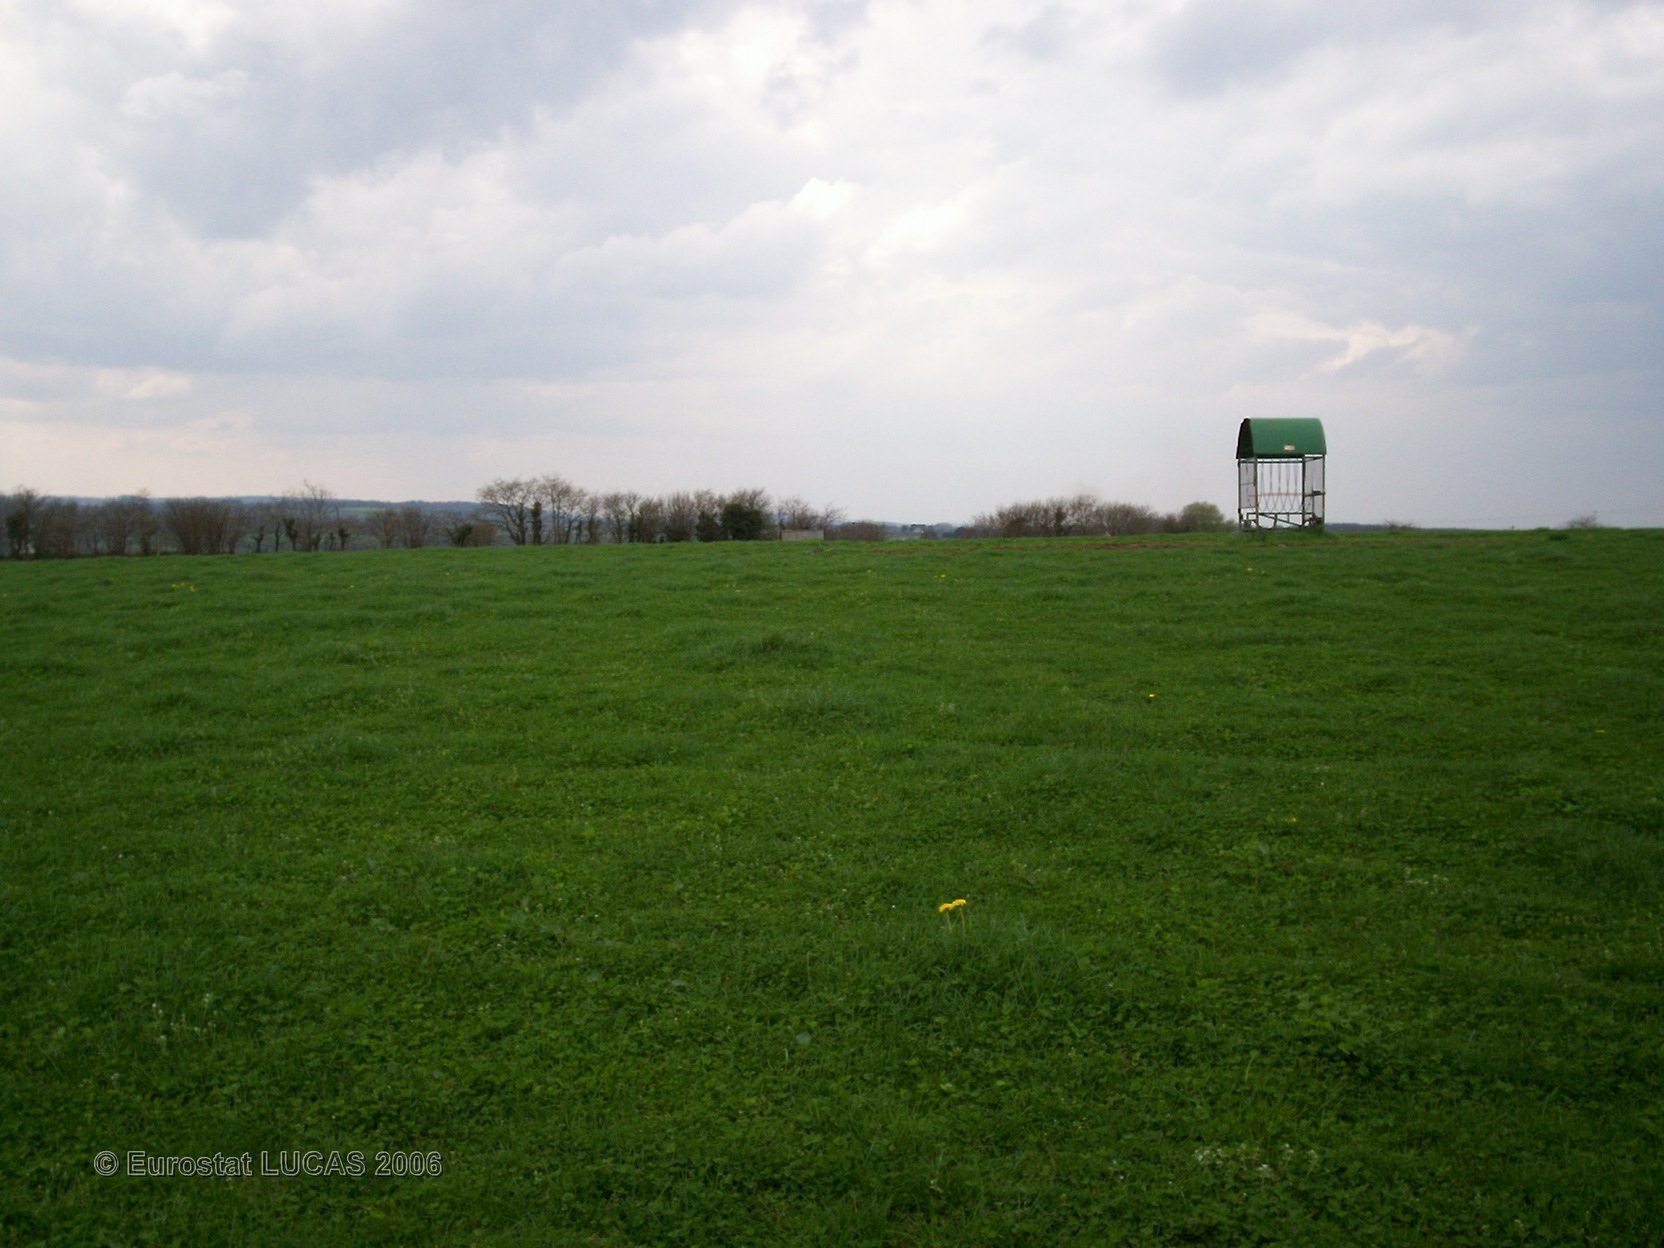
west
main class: Grassland
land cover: Grassland without tree/shrub cover
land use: Agriculture (excluding fallow land and kitchen gardens)
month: April
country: FR
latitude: 48.5044
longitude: -3.7678
